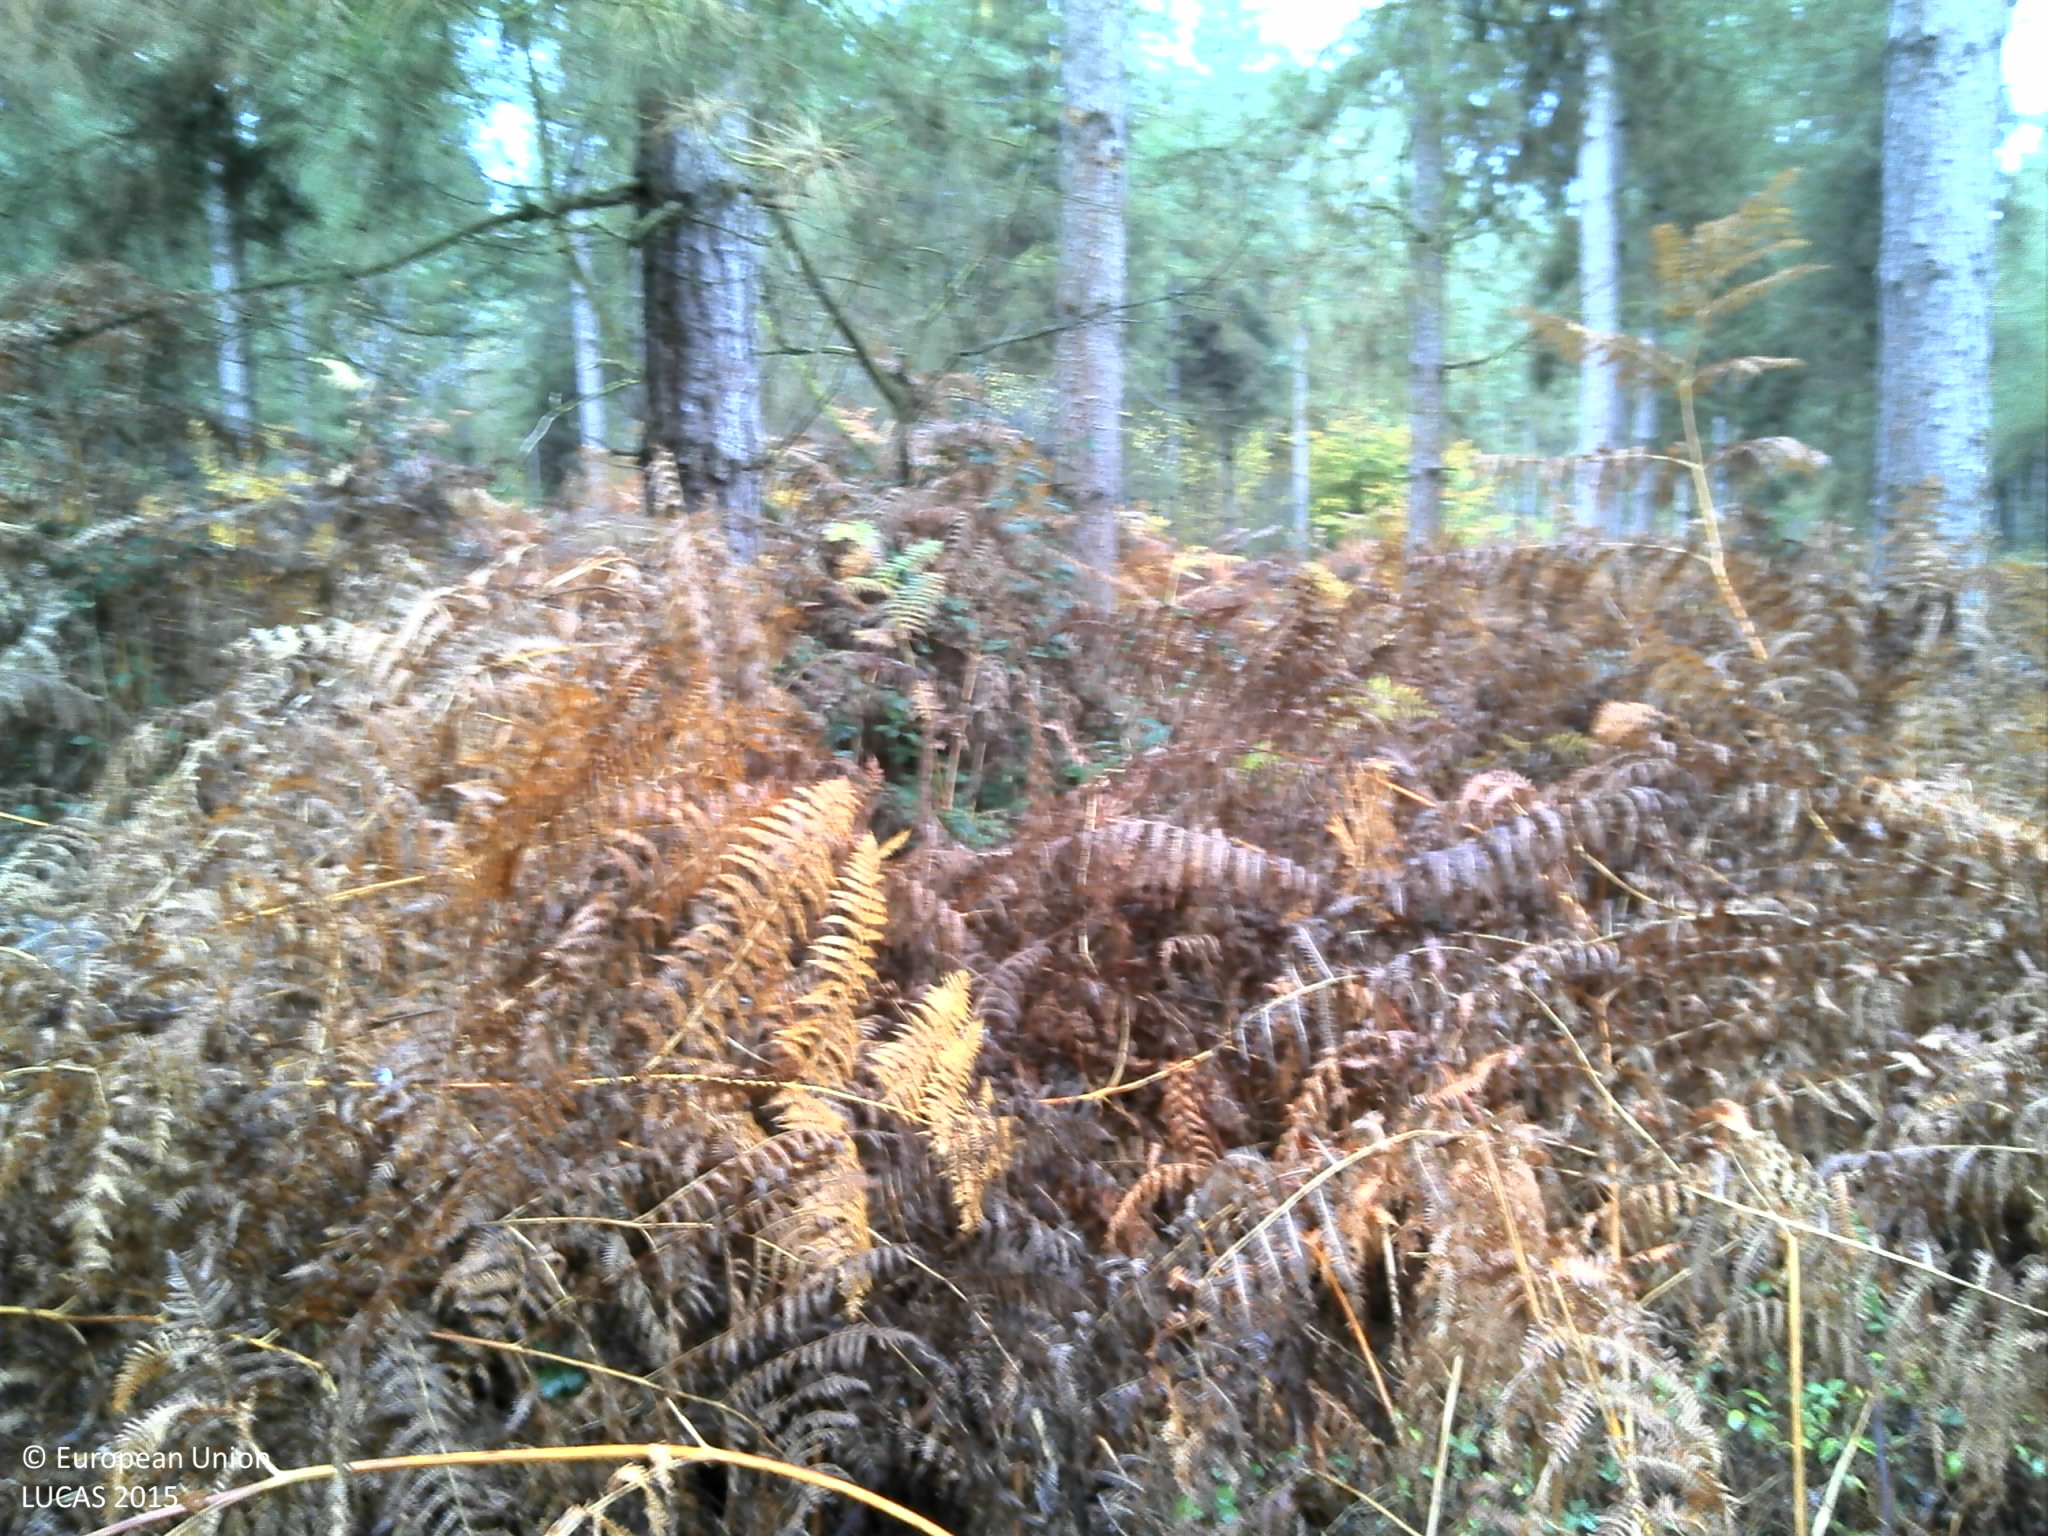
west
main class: Woodland
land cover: Pine dominated coniferous woodland
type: exotic forest
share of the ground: > 75 %
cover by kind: coniferous forest trees 85 %, herbaceous plants 15 %
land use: Forestry
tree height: > 5 m
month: November
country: FR
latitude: 47.6878
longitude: -1.5417
